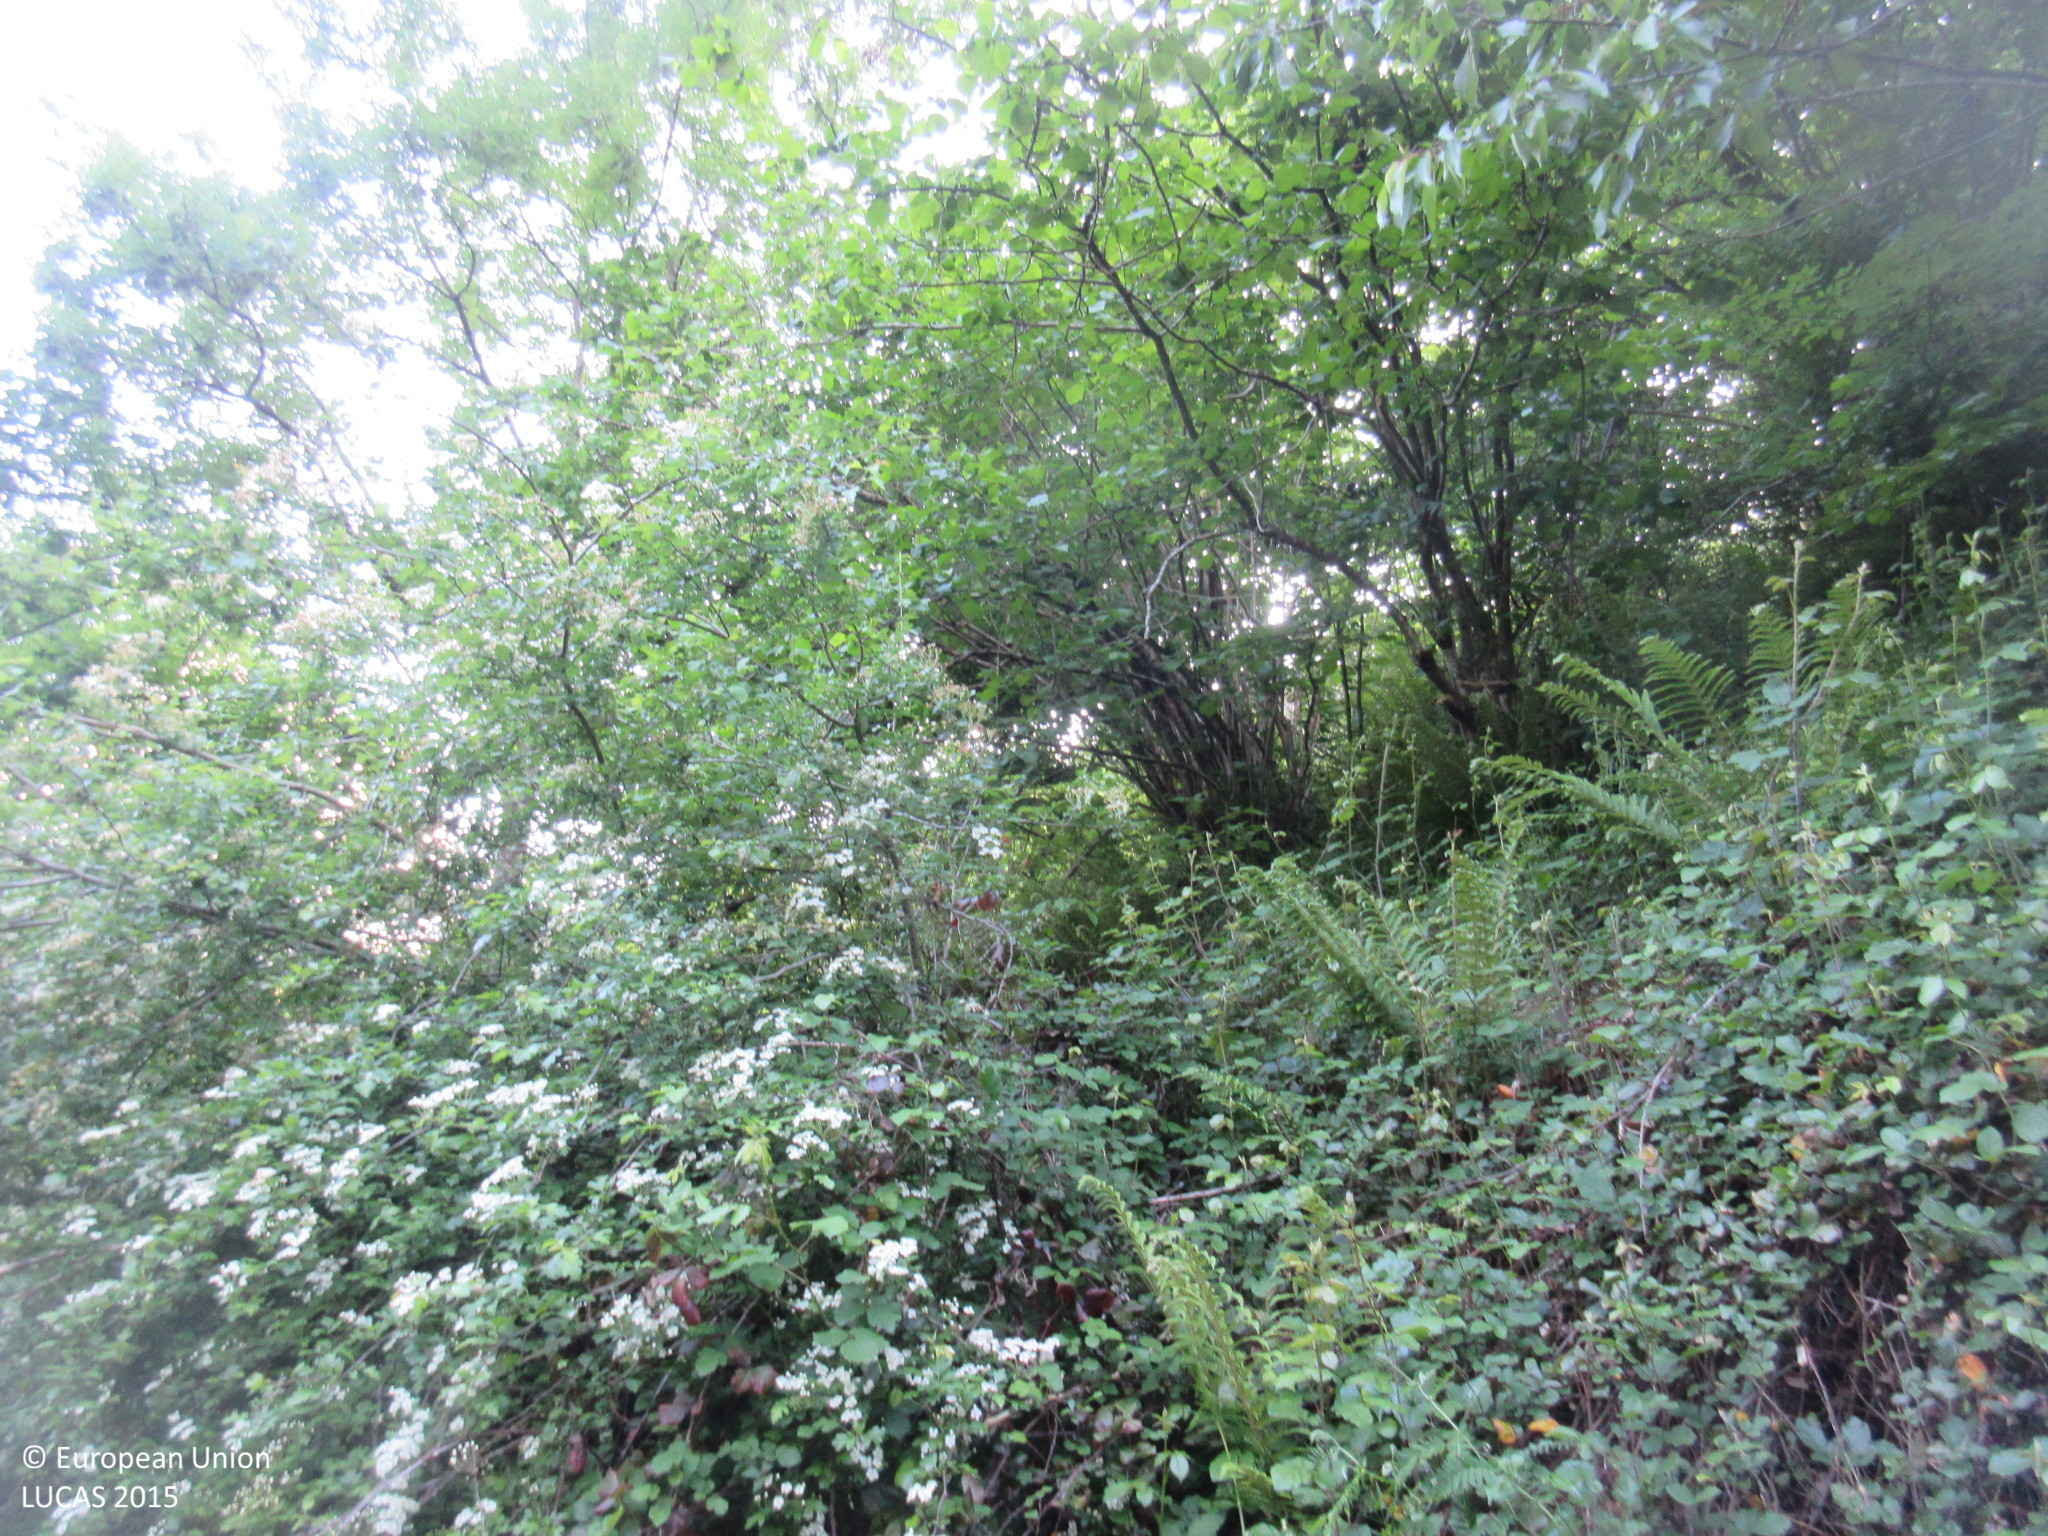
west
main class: Woodland
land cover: Broadleaved woodland
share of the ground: > 75 %
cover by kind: broadleaved forest trees 95 %, shrubs 5 %
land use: Semi-natural and natural areas not in use
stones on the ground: 25 - 50 %
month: May
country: ES
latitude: 43.1183
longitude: -5.5268
